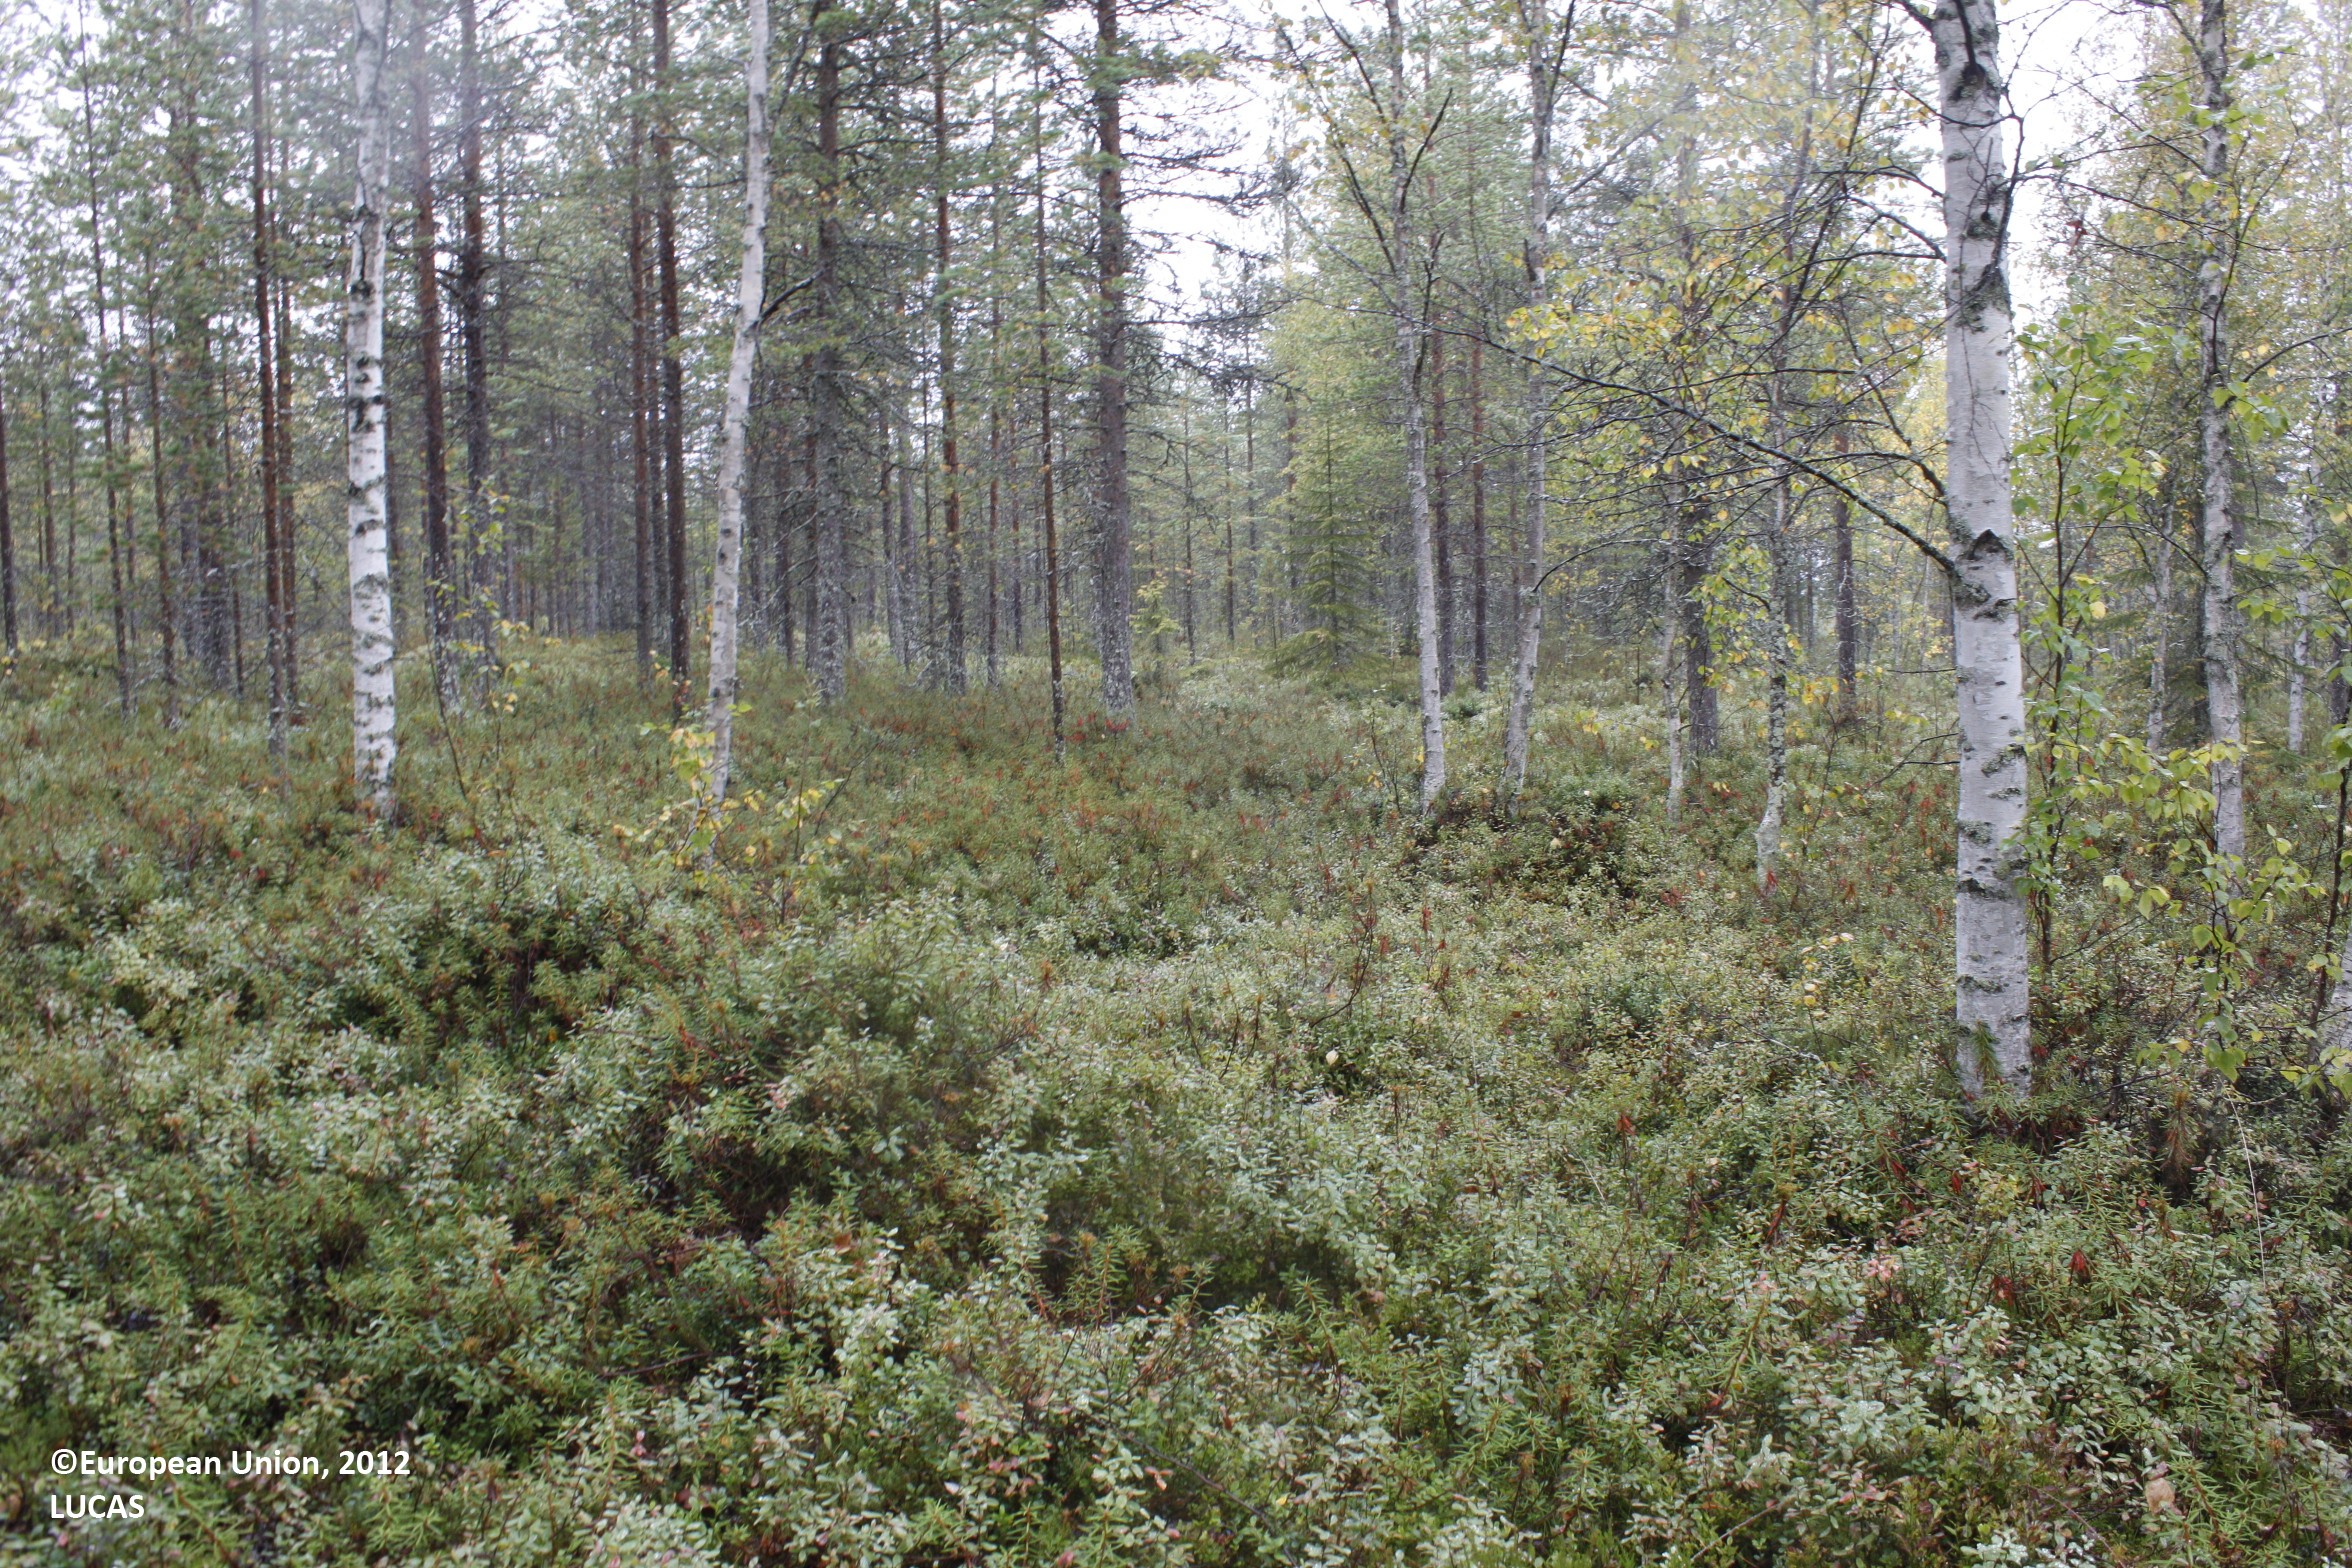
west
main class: Woodland
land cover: Pine dominated mixed woodland
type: mire and swamp forests
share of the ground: 25 - 50 %
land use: Forestry
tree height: > 5 m
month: September
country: FI
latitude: 65.3362
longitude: 26.9315
